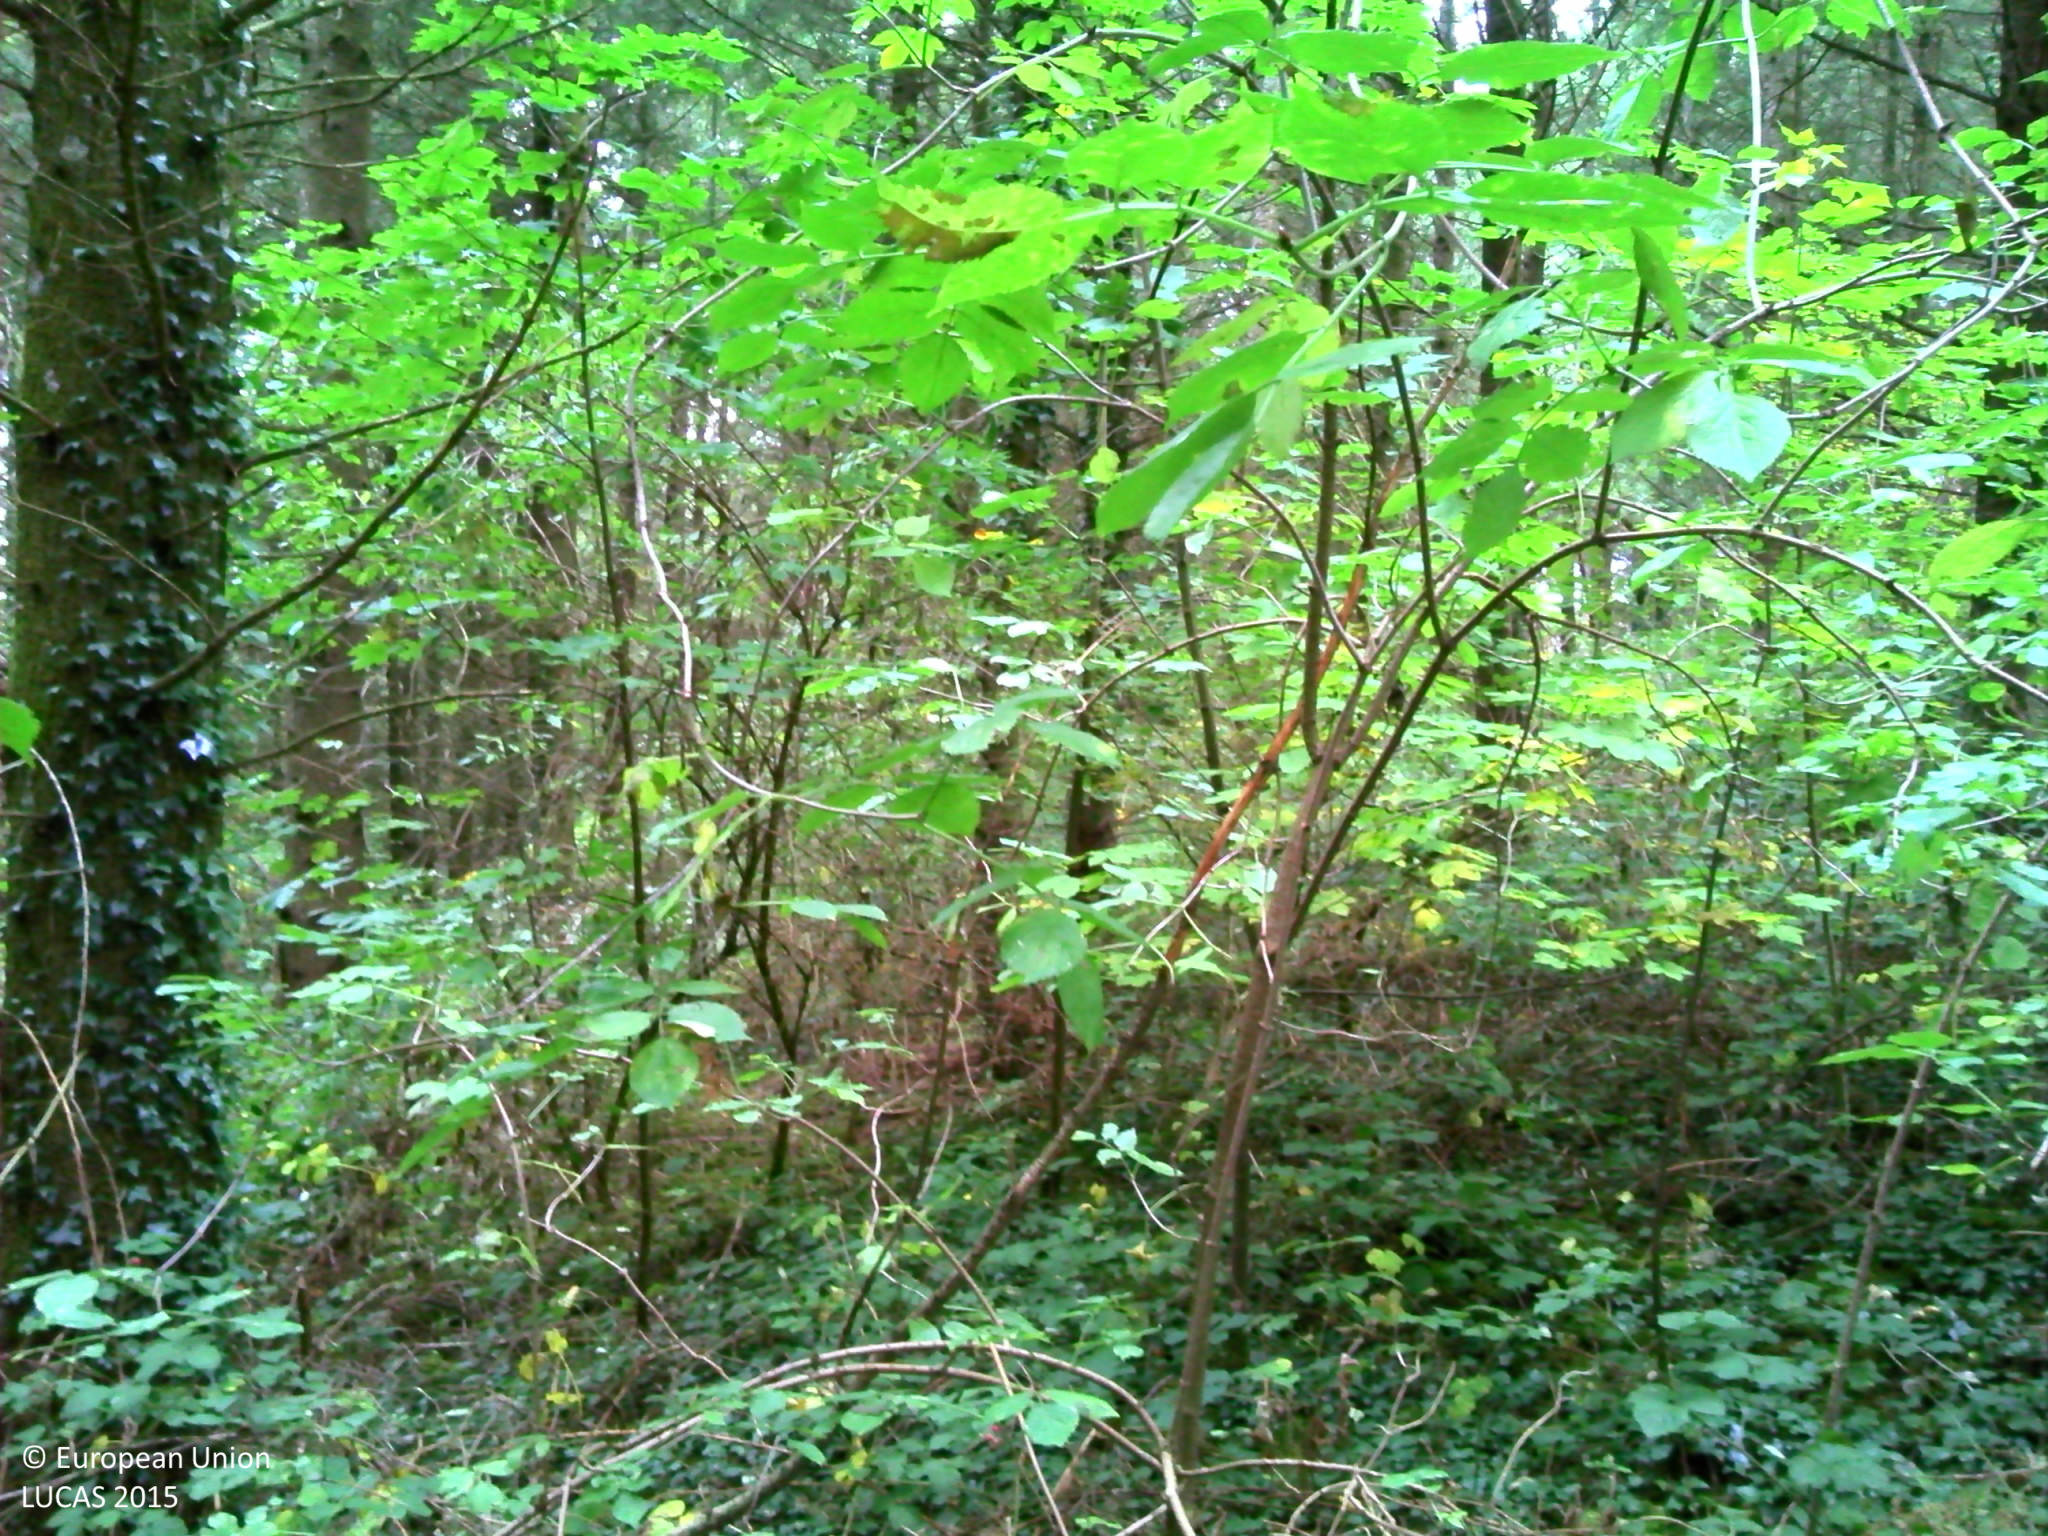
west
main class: Woodland
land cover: Other coniferous woodland
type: exotic forest
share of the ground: > 75 %
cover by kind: coniferous forest trees 80 %, herbaceous plants 15 %, broadleaved forest trees 5 %
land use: Forestry
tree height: > 5 m
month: October
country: FR
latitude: 45.9627
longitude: 2.7848
